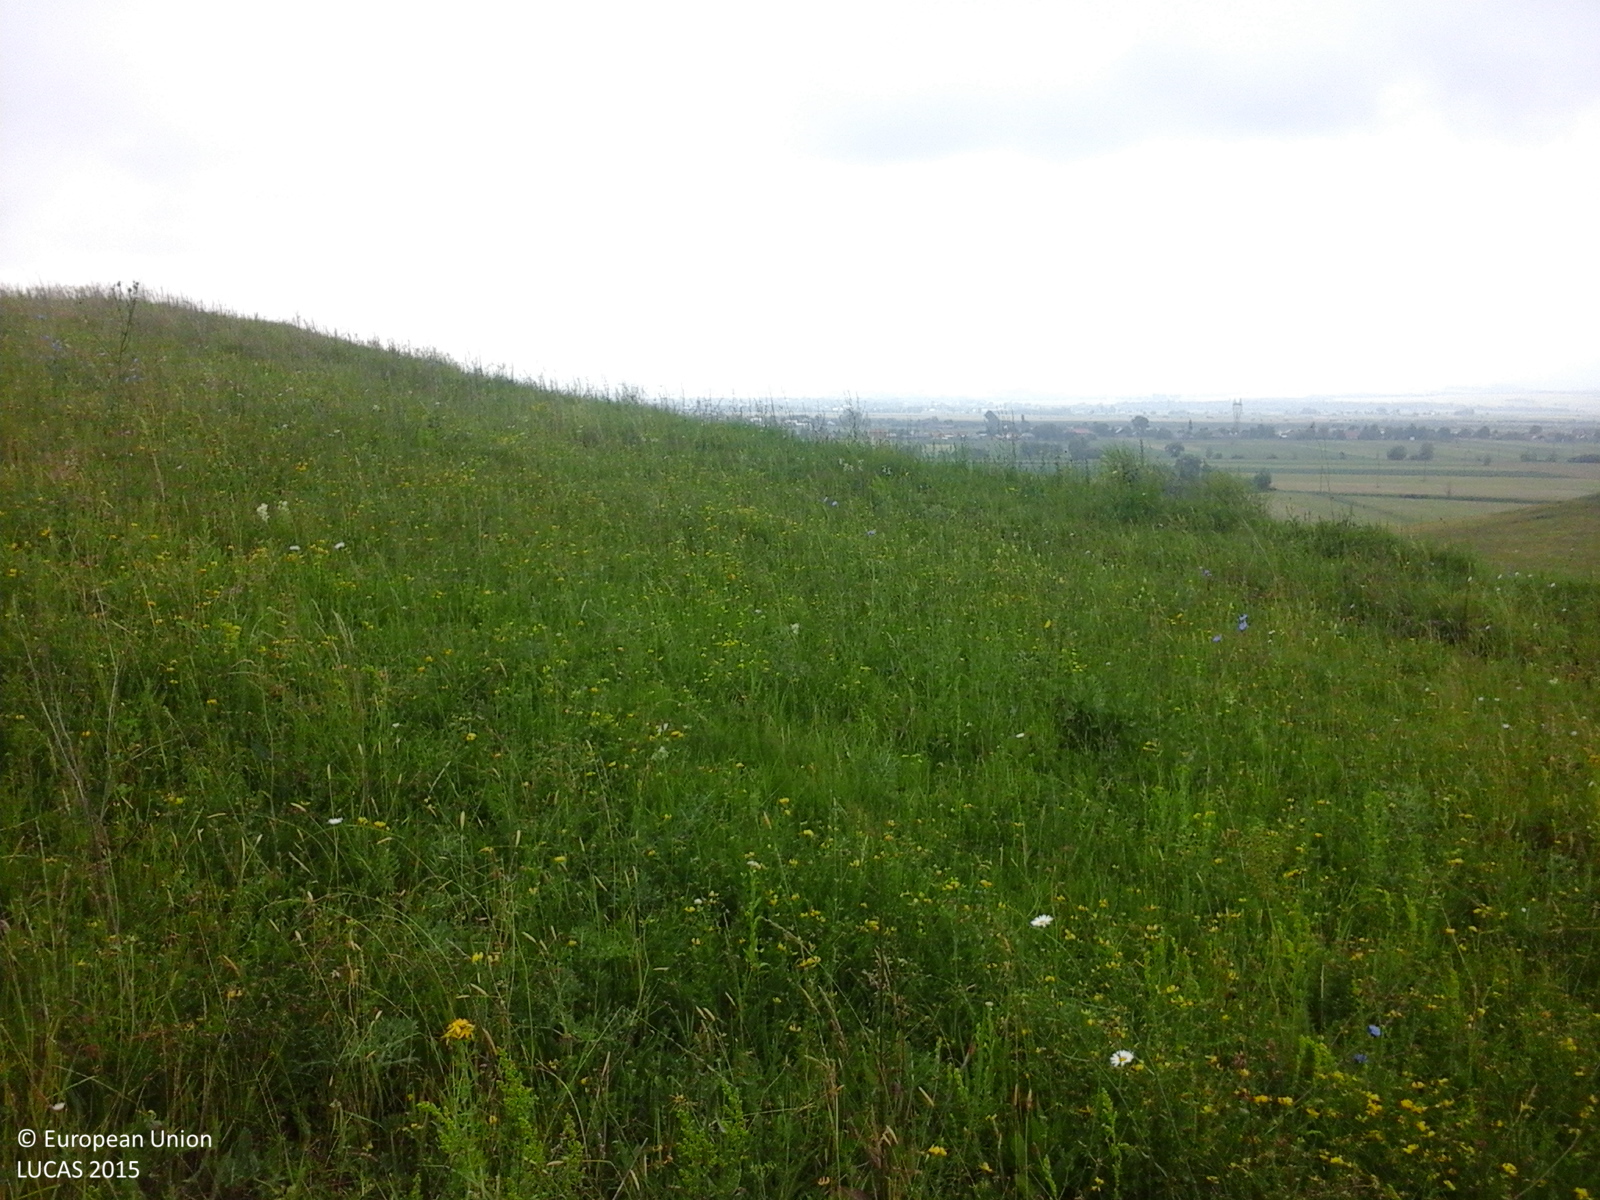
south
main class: Grassland
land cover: Grassland without tree/shrub cover
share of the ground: > 75 %
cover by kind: herbaceous plants 100 %
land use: Agriculture (excluding fallow land and kitchen gardens)
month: June
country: RO
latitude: 47.3931
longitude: 26.3669
